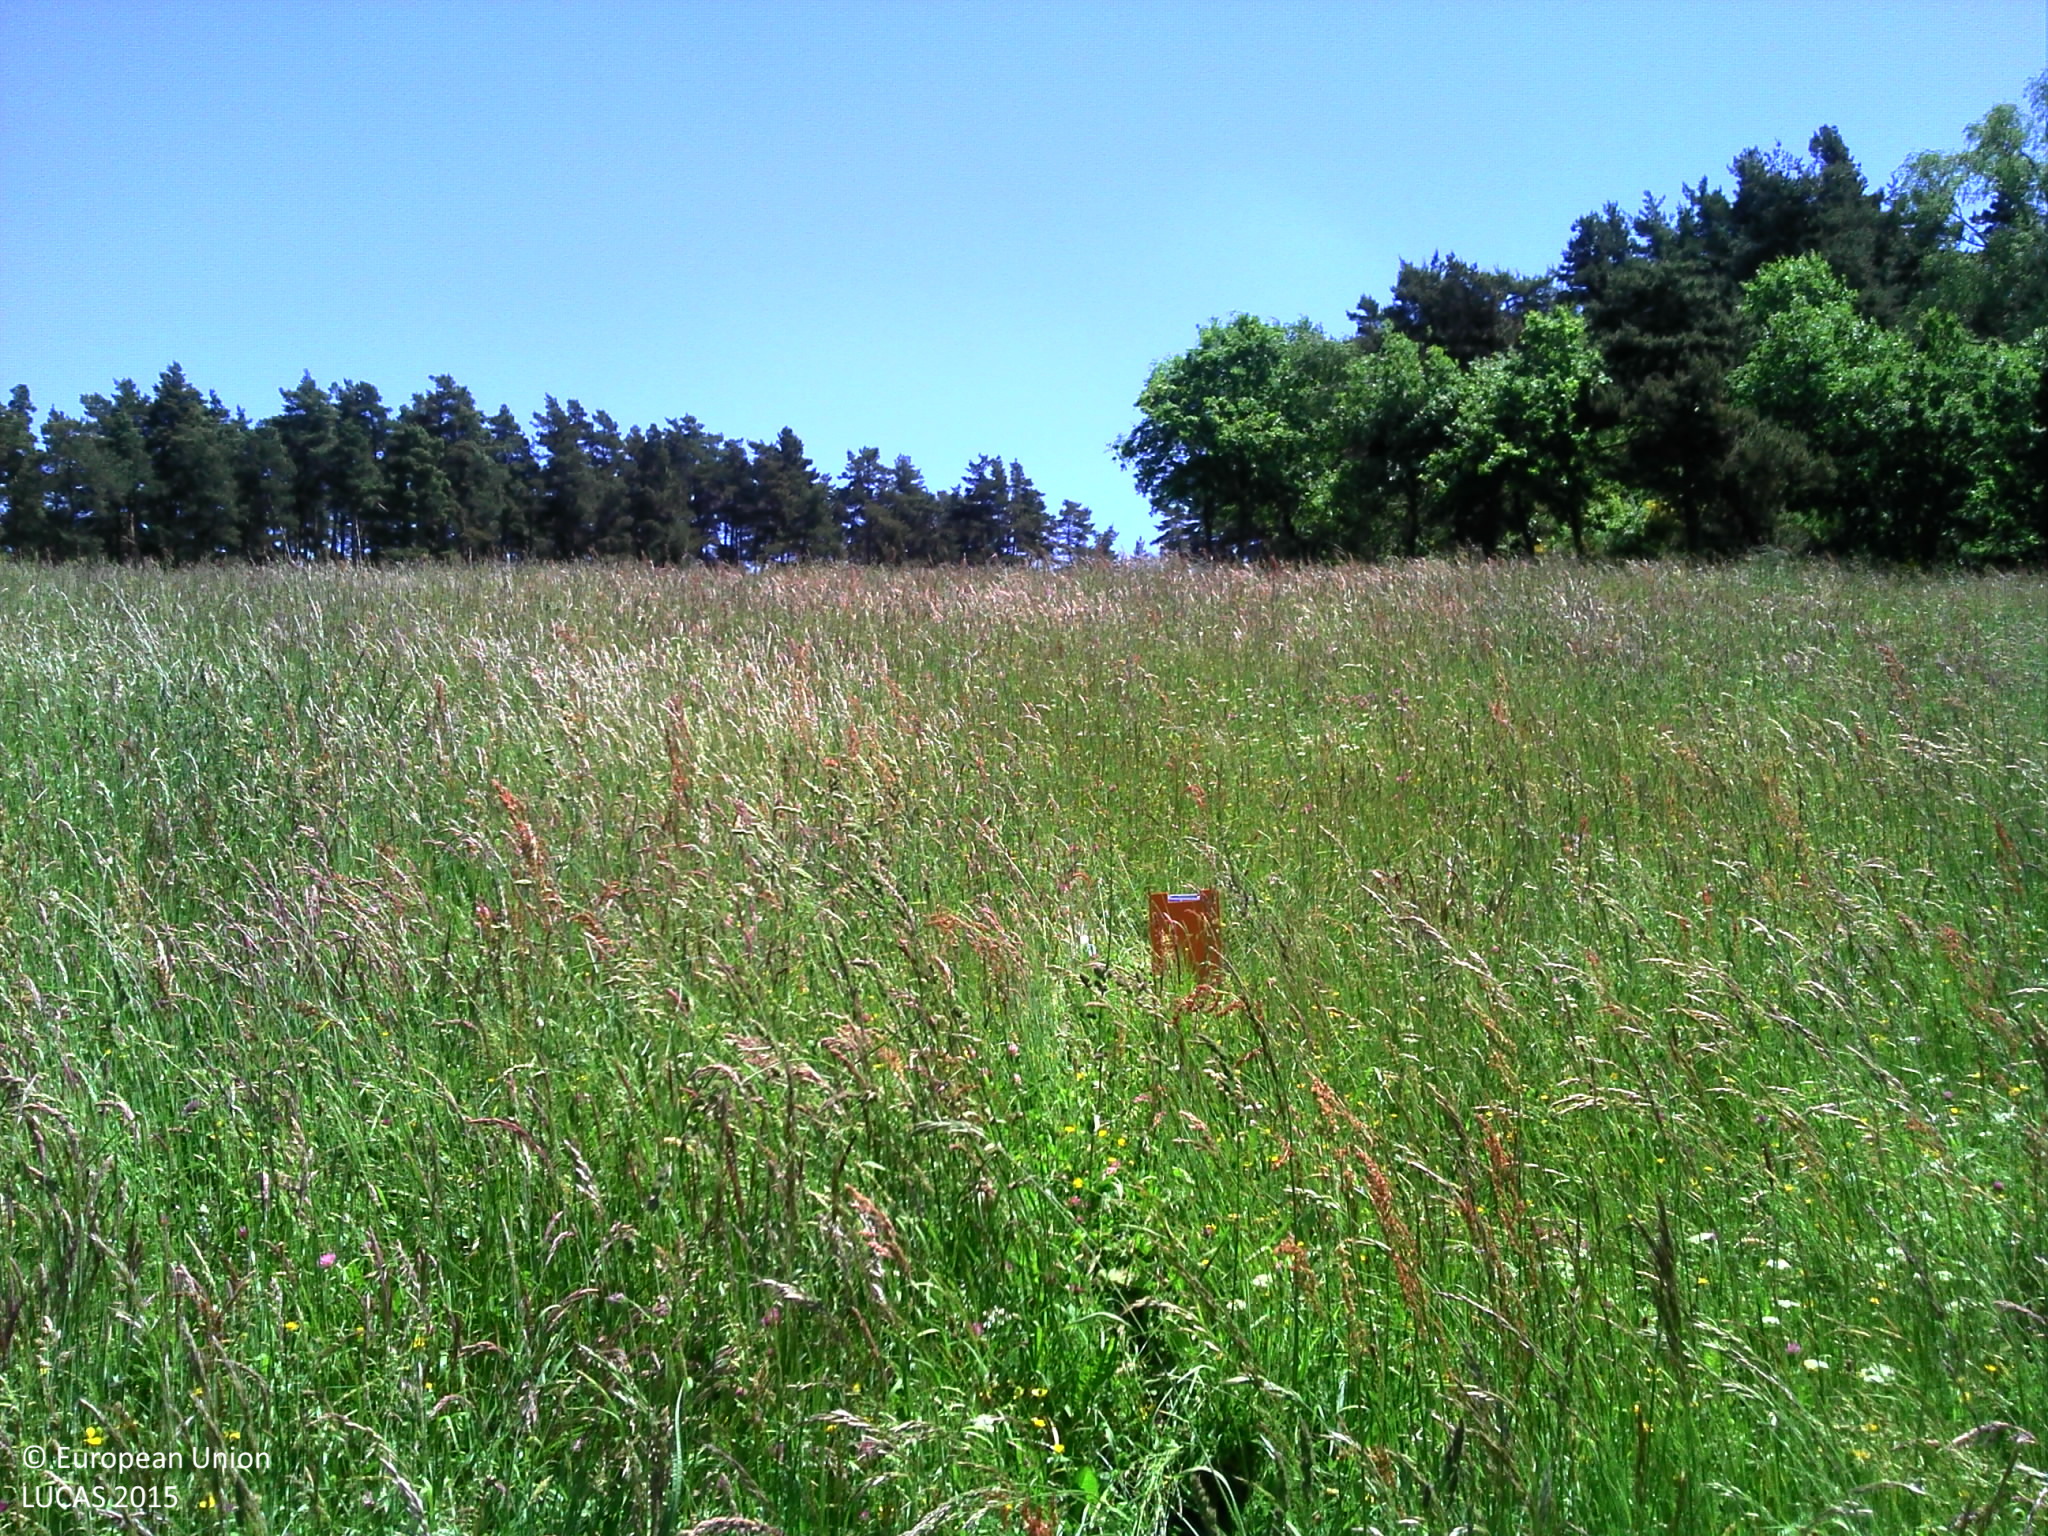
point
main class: Grassland
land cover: Grassland without tree/shrub cover
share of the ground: > 75 %
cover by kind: herbaceous plants 100 %
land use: Agriculture (excluding fallow land and kitchen gardens)
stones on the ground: < 10 %
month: June
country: FR
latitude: 44.9560
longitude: 3.1449
